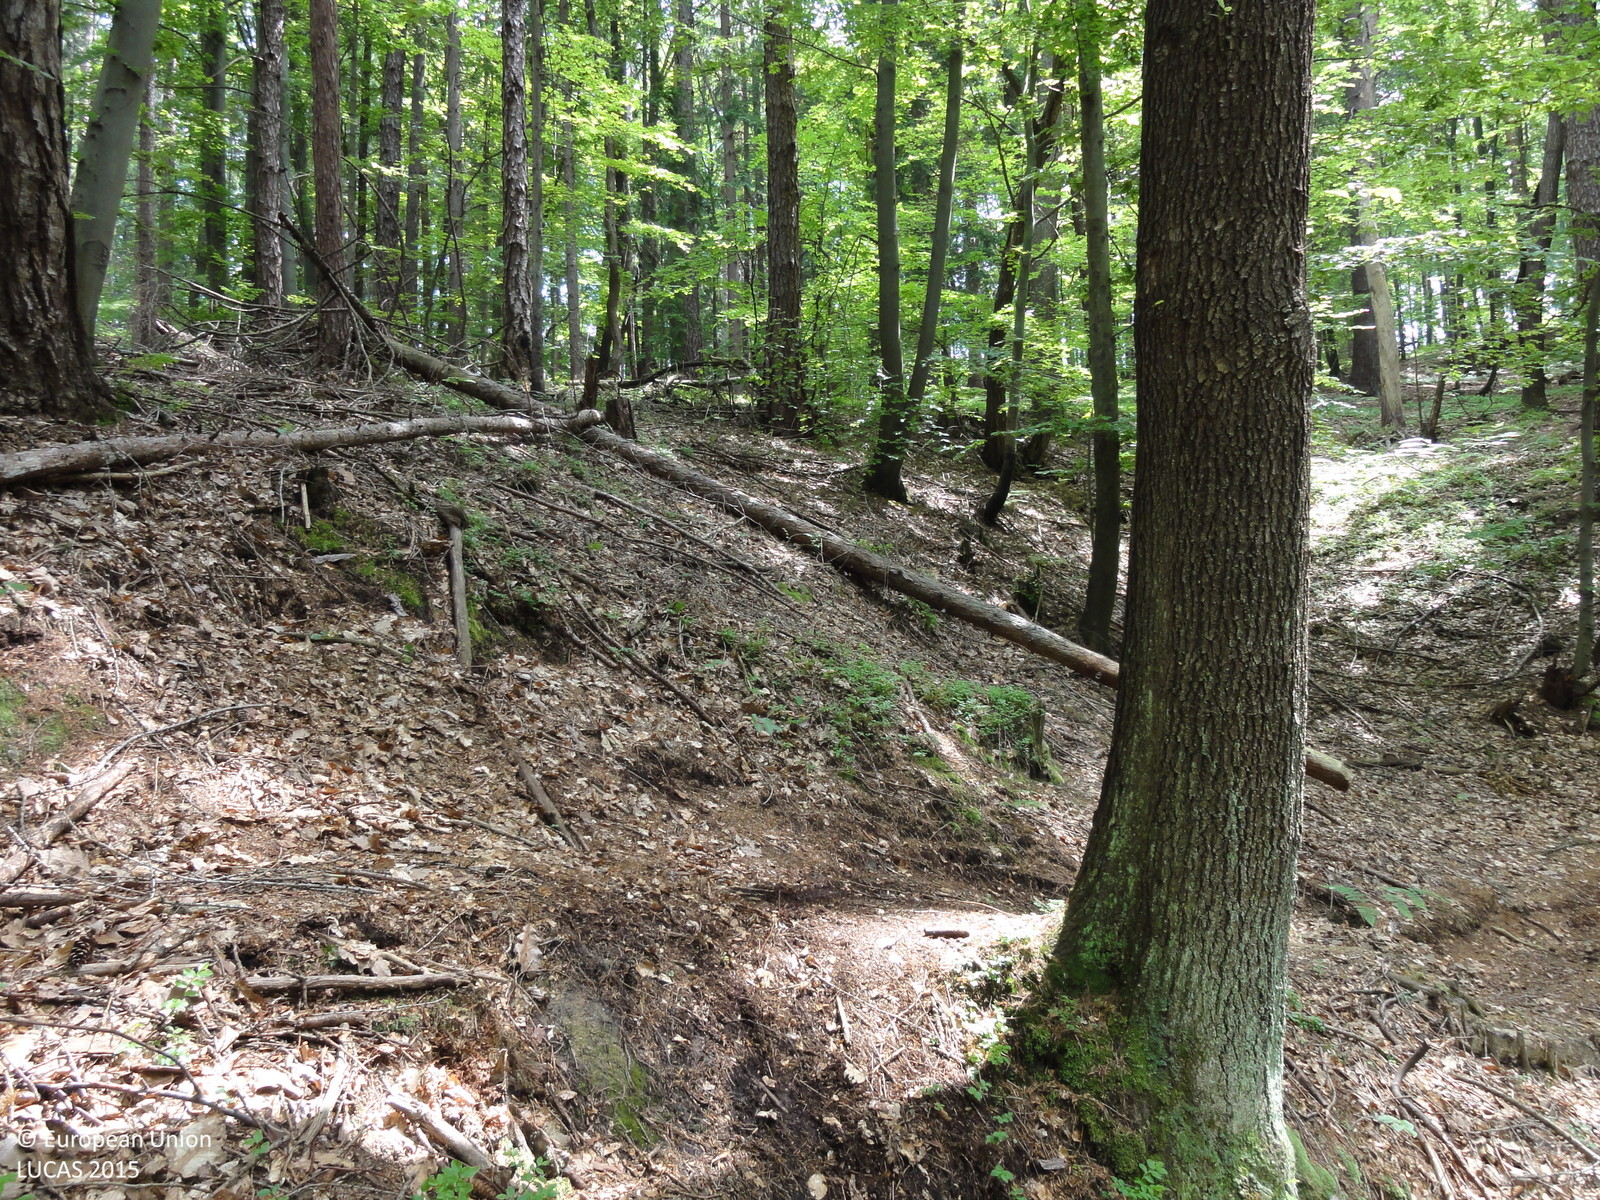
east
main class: Woodland
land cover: Other mixed woodland
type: mountainous beech forest
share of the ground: > 75 %
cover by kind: coniferous forest trees 50 %, broadleaved forest trees 50 %
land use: Forestry
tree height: > 5 m
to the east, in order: Other mixed woodland; Tracks; Other mixed woodland; Tracks; Other mixed woodland; Ditches and canals; Other mixed woodland; Tracks; Spruce dominated mixed woodland; Grassland without tree/shrub cover; Apple fruit; Artificial constructions in urban areas; Other fruit trees and berries; Grassland without tree/shrub cover; Electric lines; Grassland without tree/shrub cover; Electric lines; Grassland without tree/shrub cover
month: May
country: SI
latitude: 46.2299
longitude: 15.0932
